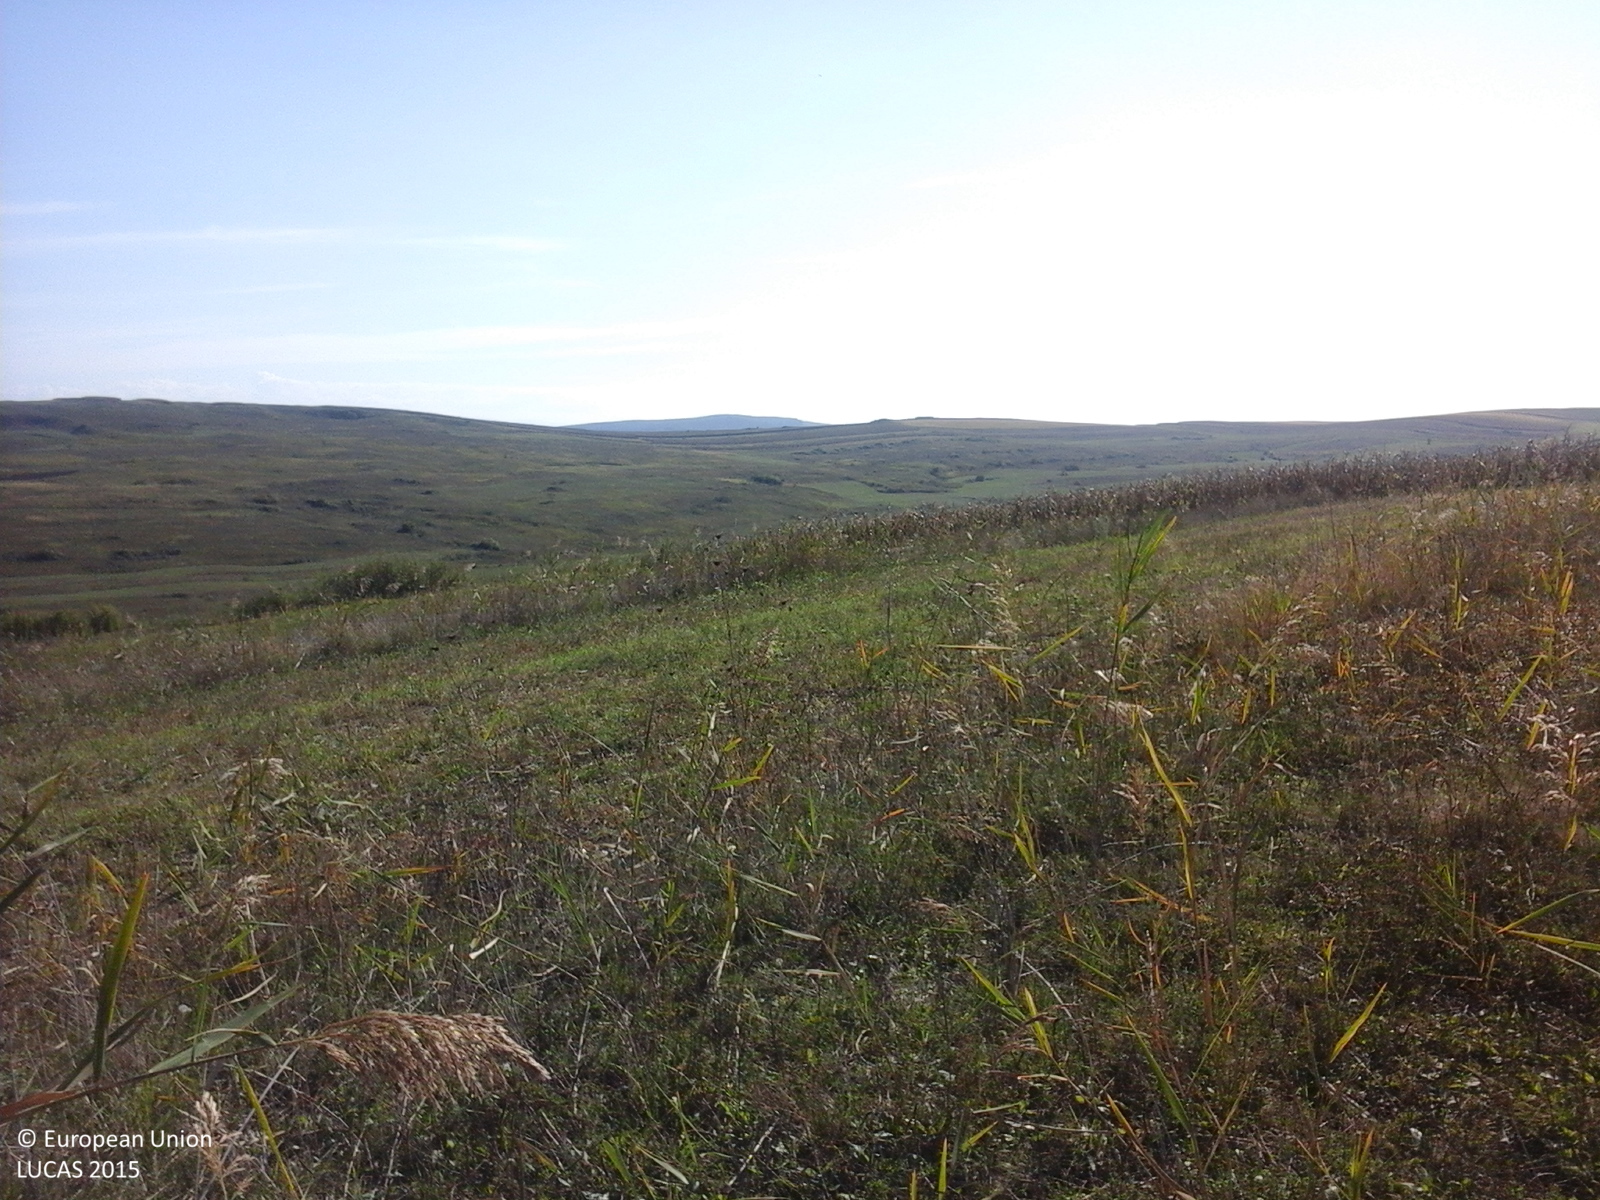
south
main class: Grassland
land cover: Spontaneously vegetated surfaces
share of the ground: > 75 %
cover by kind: herbaceous plants 100 %
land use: Fallow land
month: October
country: RO
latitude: 46.1369
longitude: 23.7257
